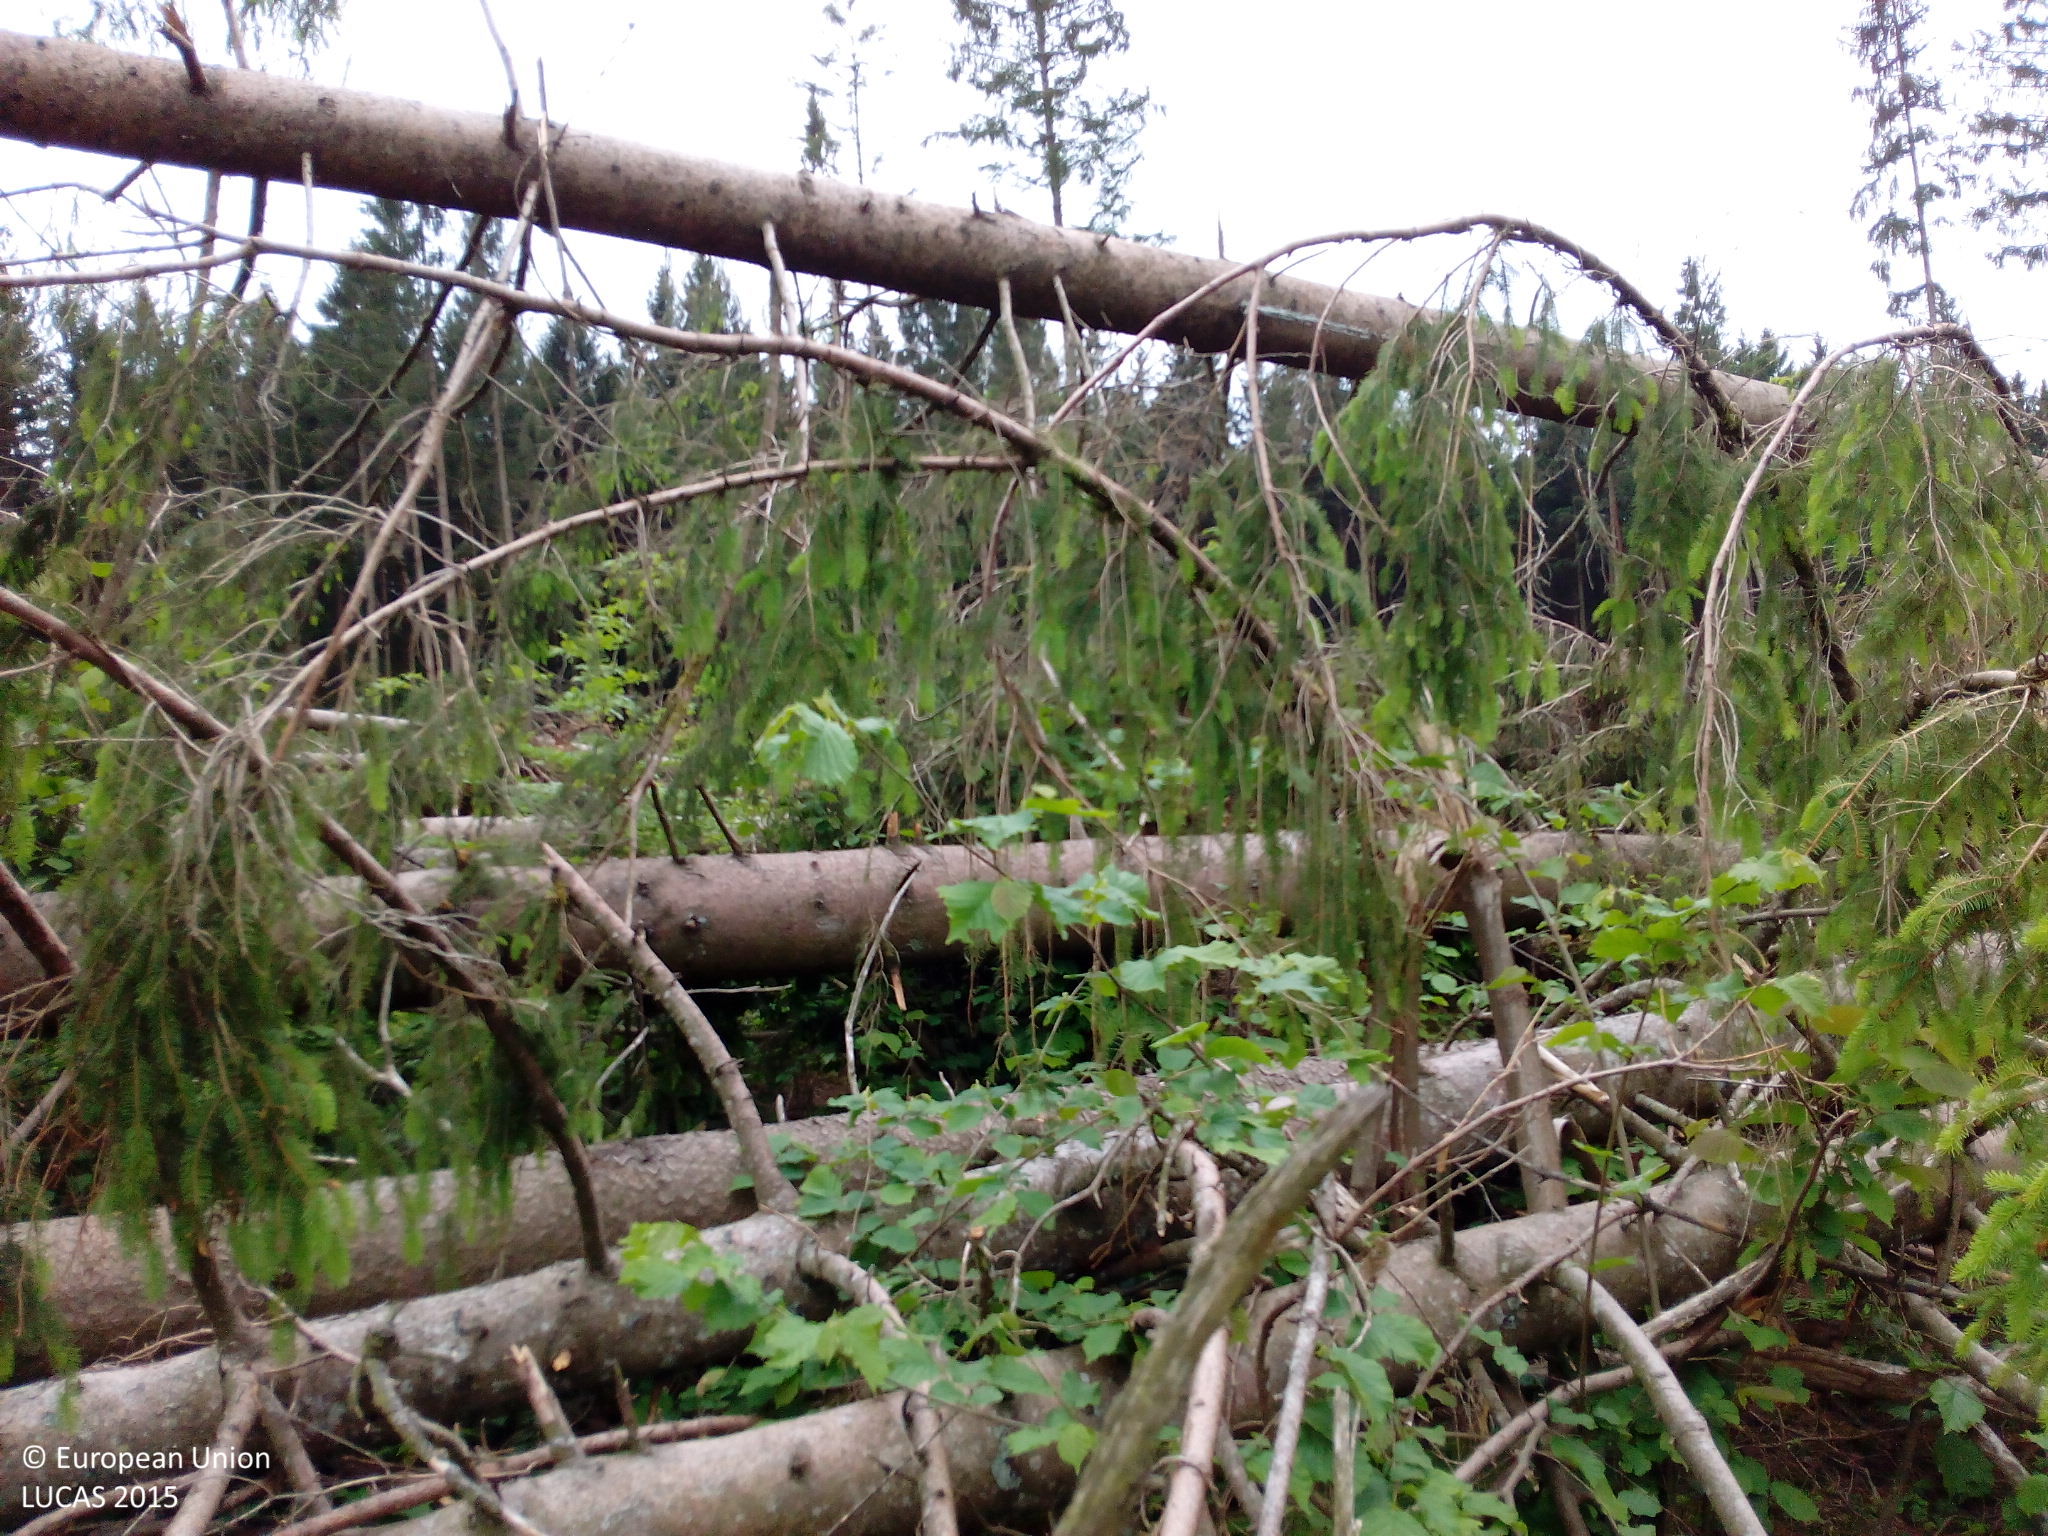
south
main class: Grassland
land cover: Spontaneously vegetated surfaces
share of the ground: > 75 %
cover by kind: herbaceous plants 95 %, shrubs 5 %
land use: Forestry
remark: Clear cut
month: May
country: DE
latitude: 48.0144
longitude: 11.5676
